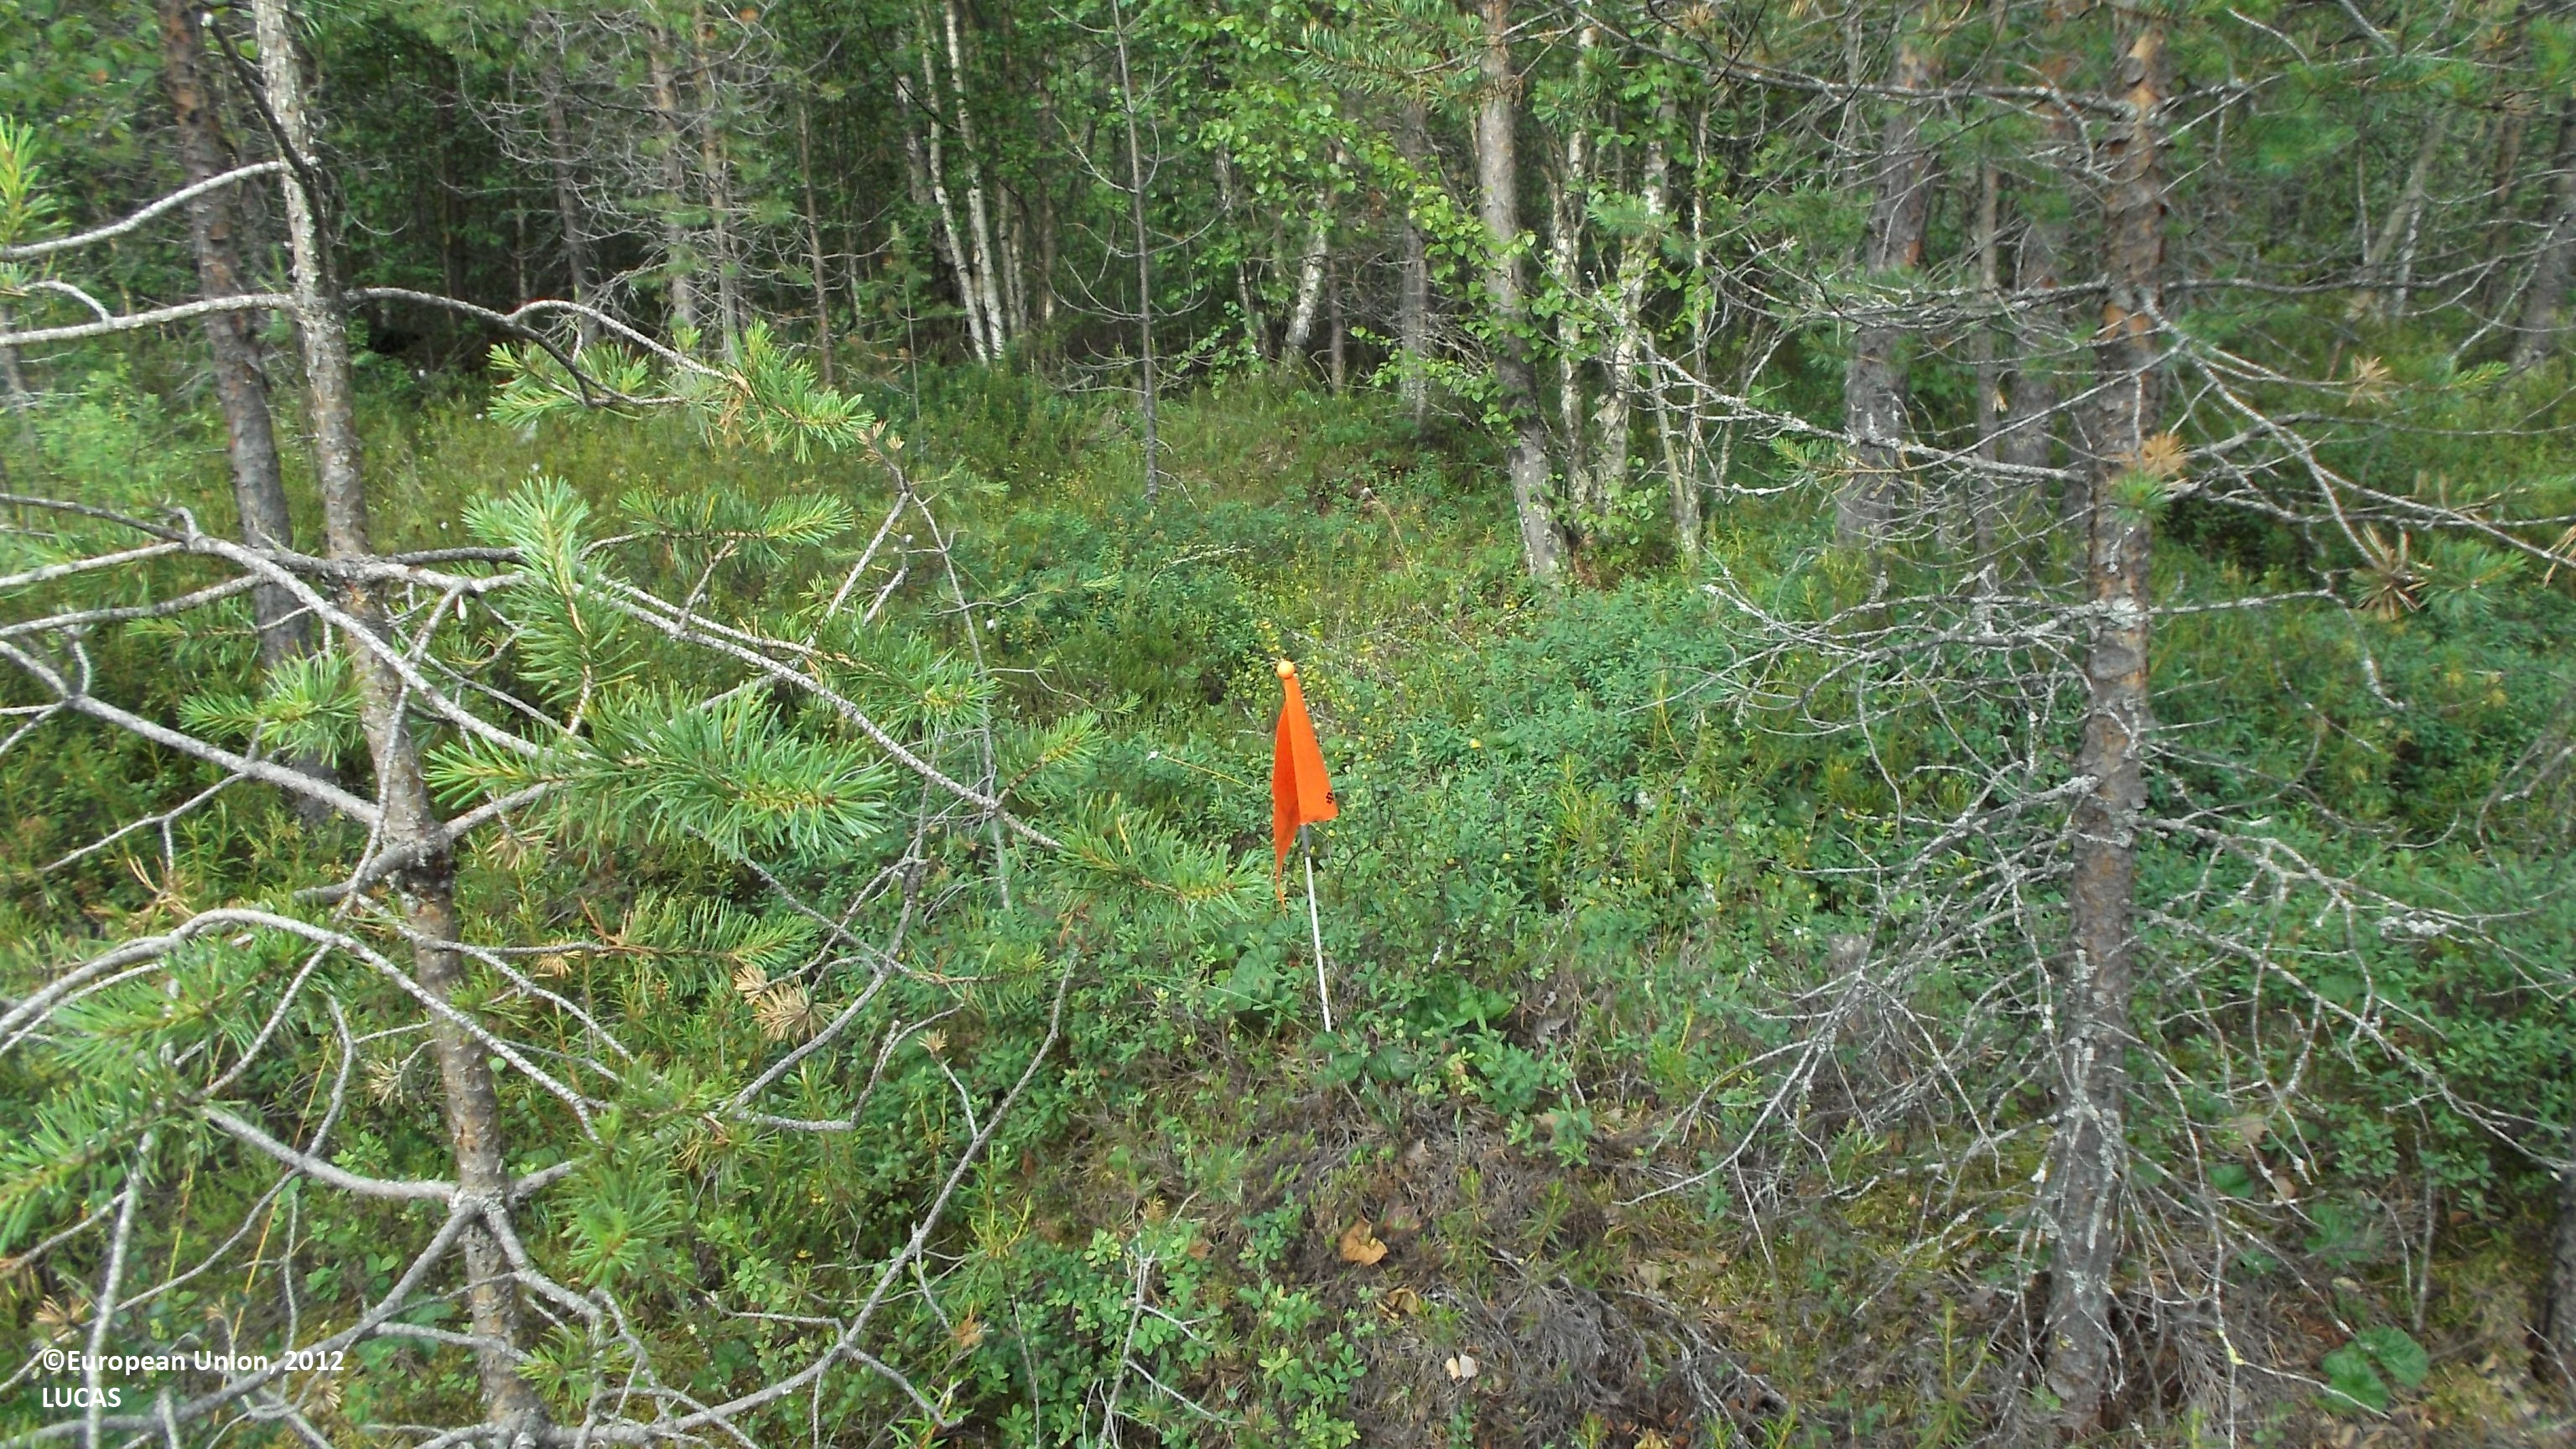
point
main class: Woodland
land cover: Pine dominated coniferous woodland
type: mire and swamp forests
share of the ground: 25 - 50 %
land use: Forestry
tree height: > 5 m
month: July
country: FI
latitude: 63.5901
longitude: 23.9941
